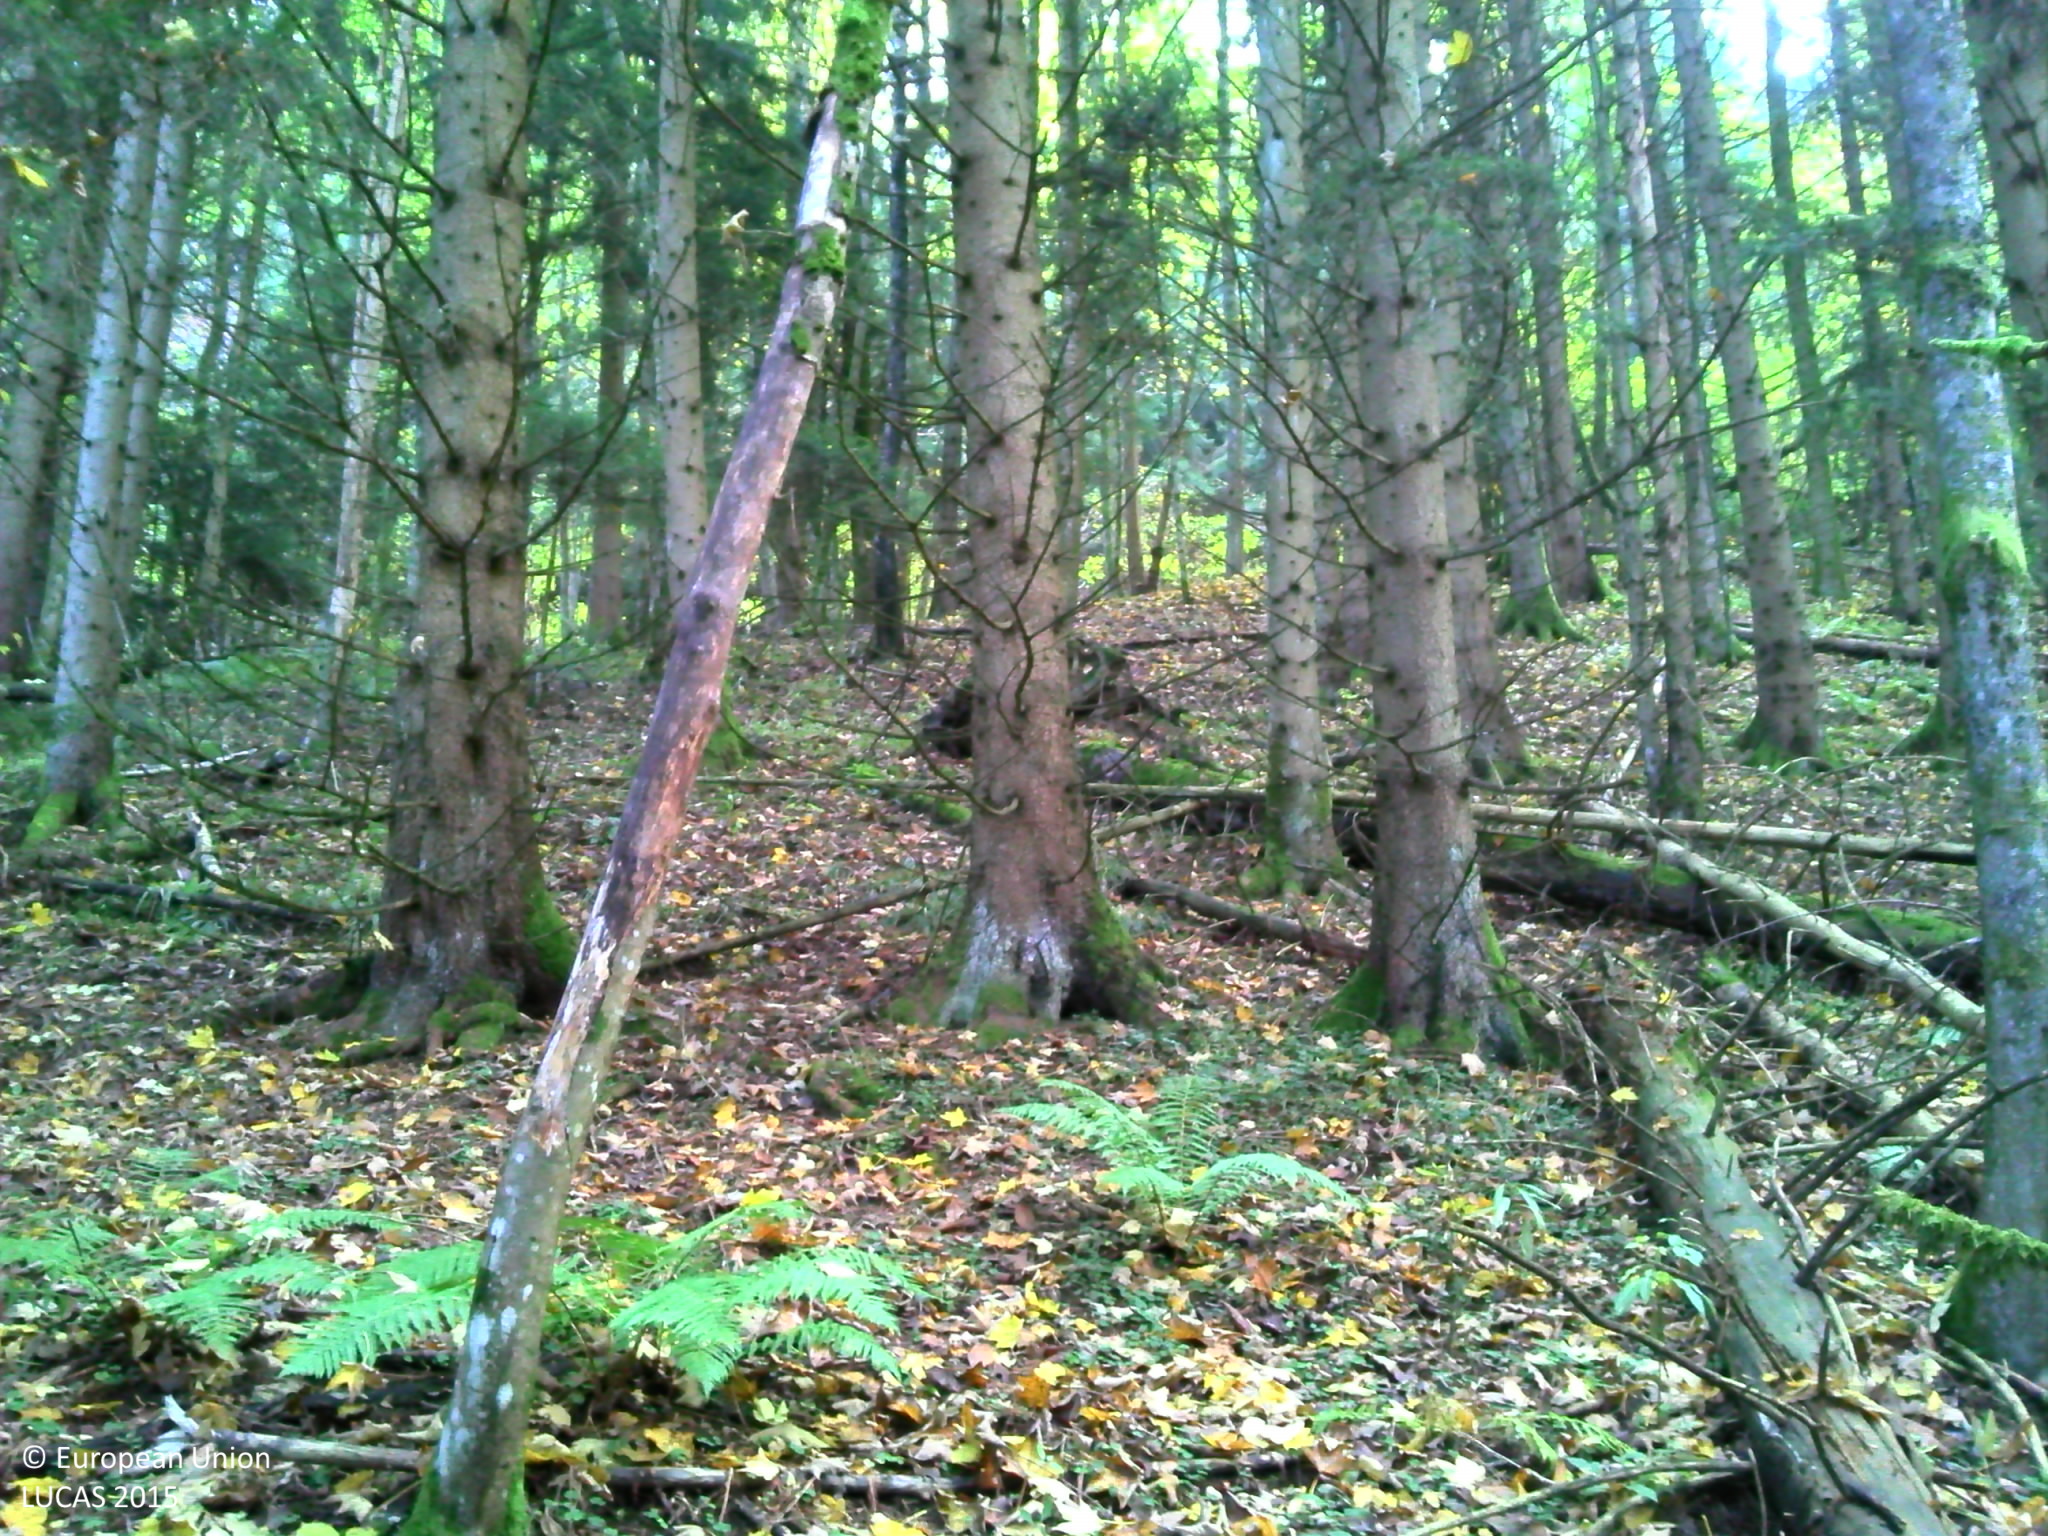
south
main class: Woodland
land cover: Spruce dominated mixed woodland
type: hemiboreal forest and nemoral coniferous forest and mixed broadleaved-coniferous forest
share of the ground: > 75 %
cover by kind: coniferous forest trees 50 %, broadleaved forest trees 35 %, unconsolidated bare surface 15 %
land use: Forestry
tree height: > 5 m
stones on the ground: < 10 %
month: October
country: FR
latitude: 45.4562
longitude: 6.2579
